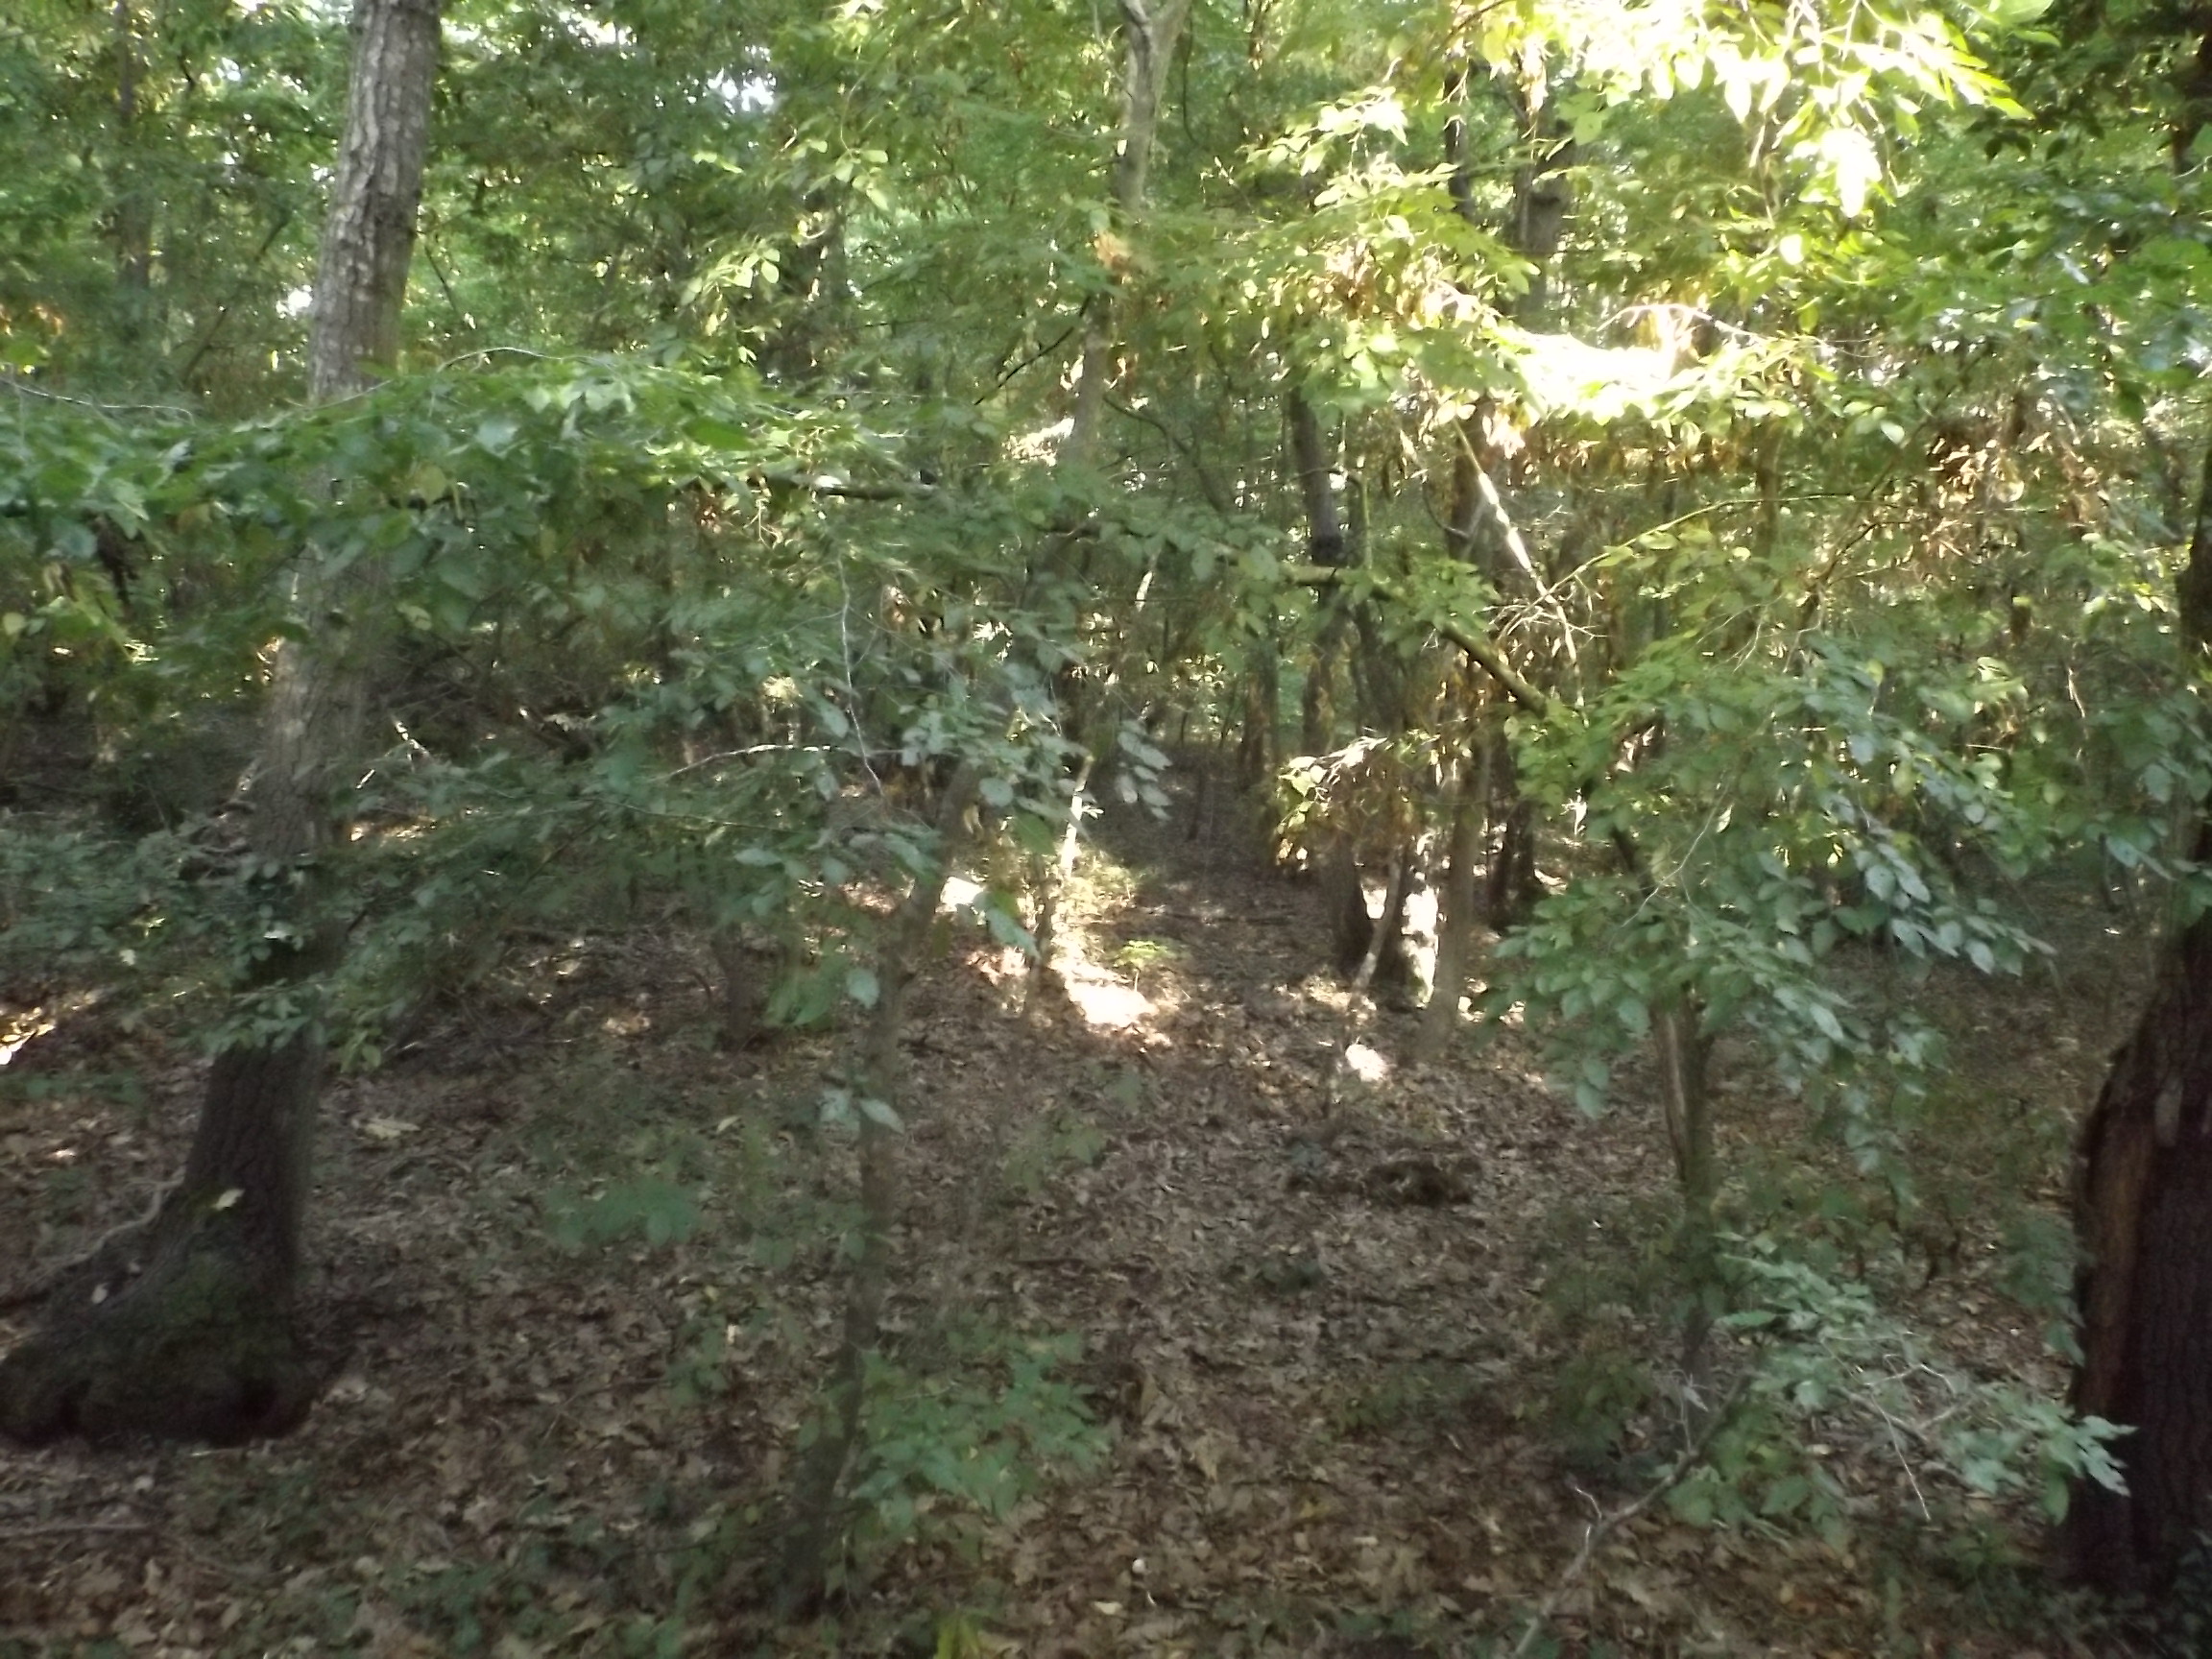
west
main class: Woodland
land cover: Broadleaved woodland
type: mesophytic deciduous forest
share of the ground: > 75 %
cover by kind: broadleaved forest trees 100 %
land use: Forestry
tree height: > 5 m
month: August
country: BG
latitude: 43.3255
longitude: 28.0382
